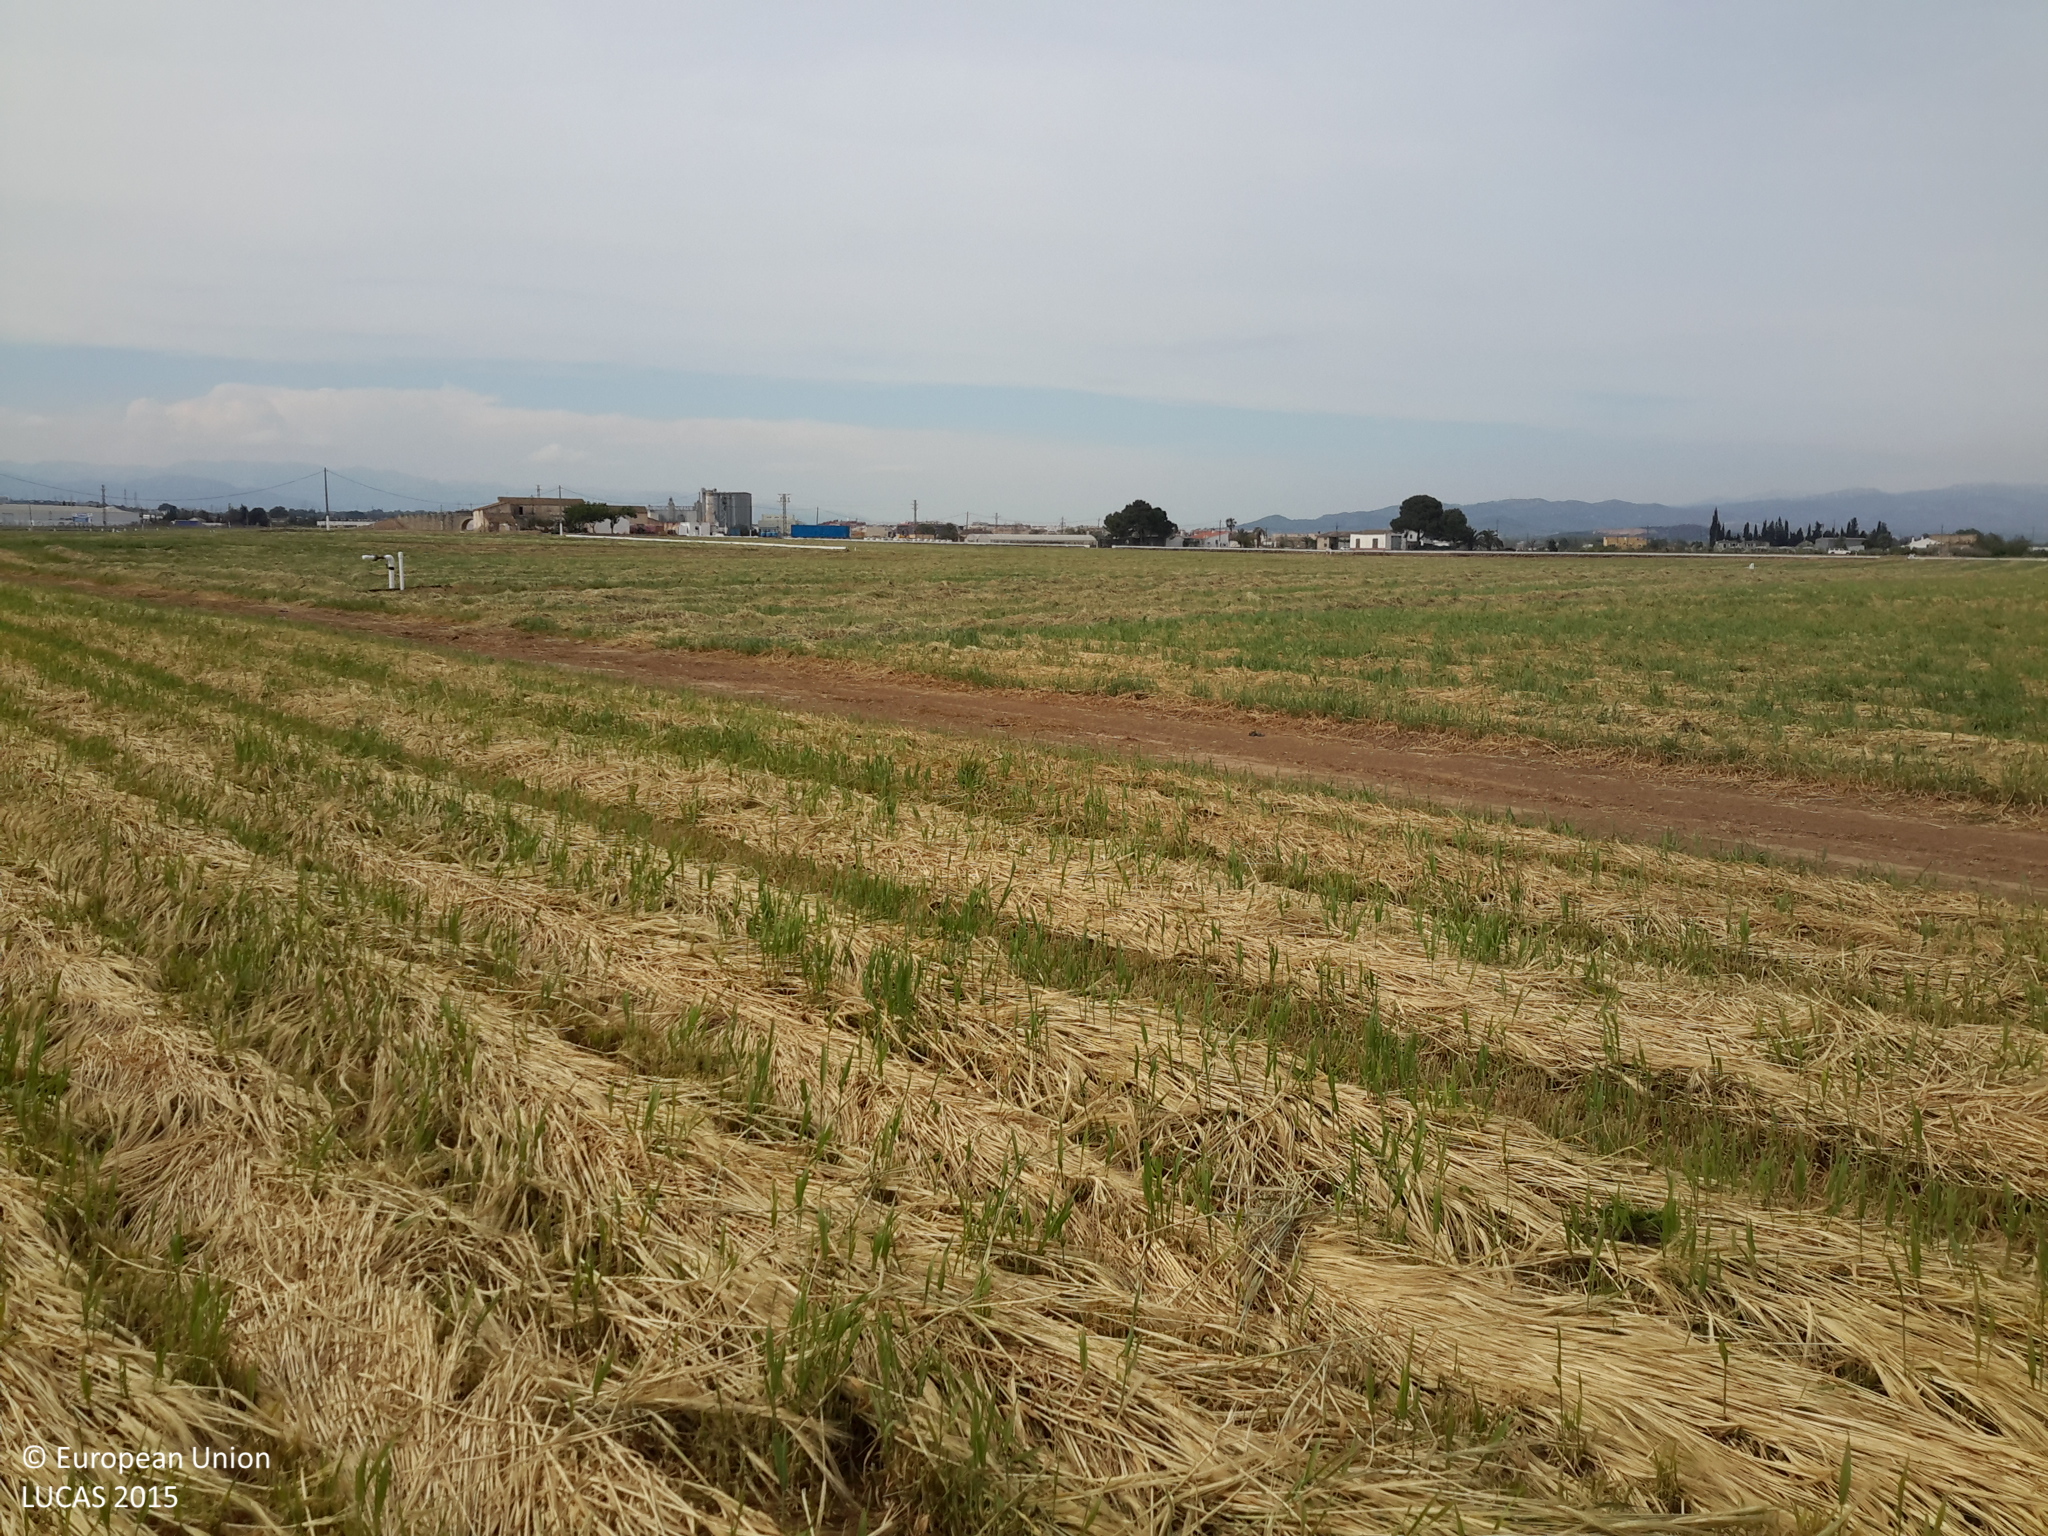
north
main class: Cropland
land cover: Common wheat
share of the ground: > 75 %
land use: Agriculture (excluding fallow land and kitchen gardens)
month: April
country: ES
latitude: 40.6876
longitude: 0.5881
